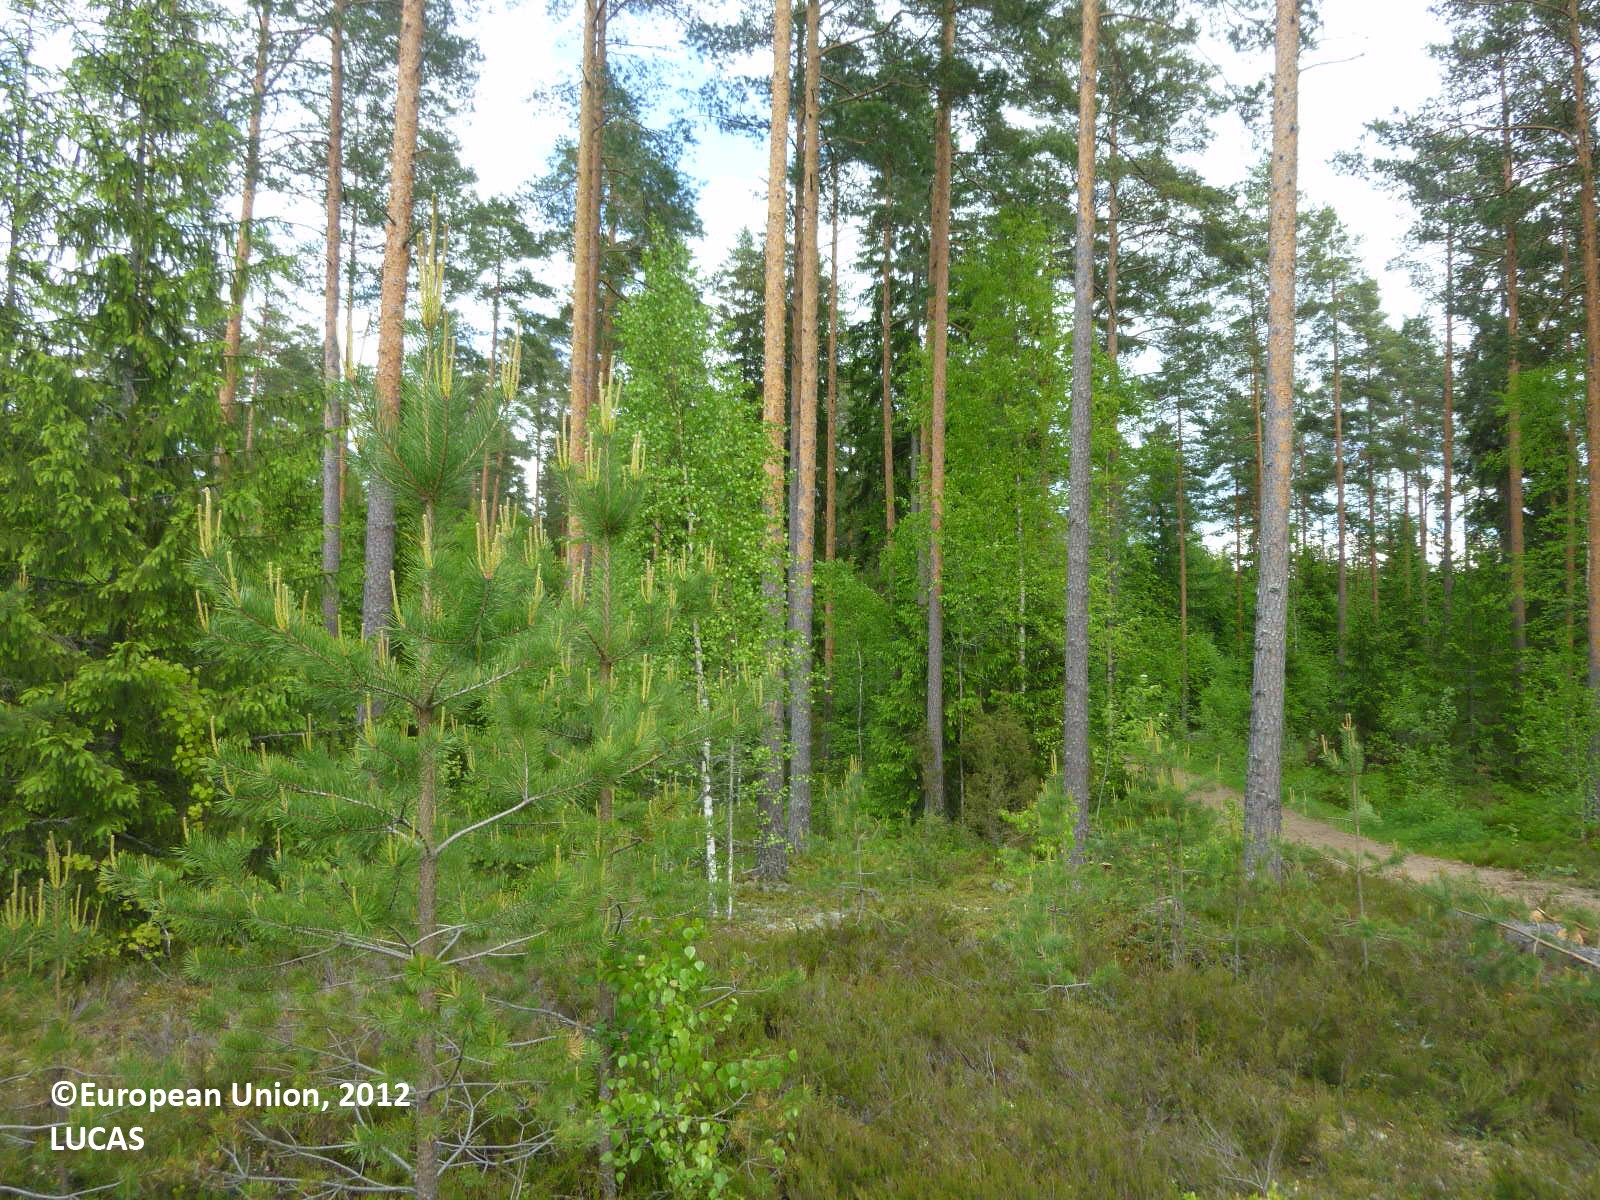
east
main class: Woodland
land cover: Pine dominated coniferous woodland
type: boreal forest
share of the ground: 25 - 50 %
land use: Forestry
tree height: > 5 m
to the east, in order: Pine dominated coniferous woodland; Spruce dominated coniferous woodland; Pine dominated coniferous woodland; Grass margins; Tracks; Grass margins; Pine dominated coniferous woodland; Pine dominated mixed woodland
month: June
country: FI
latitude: 60.5850
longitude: 22.7597
